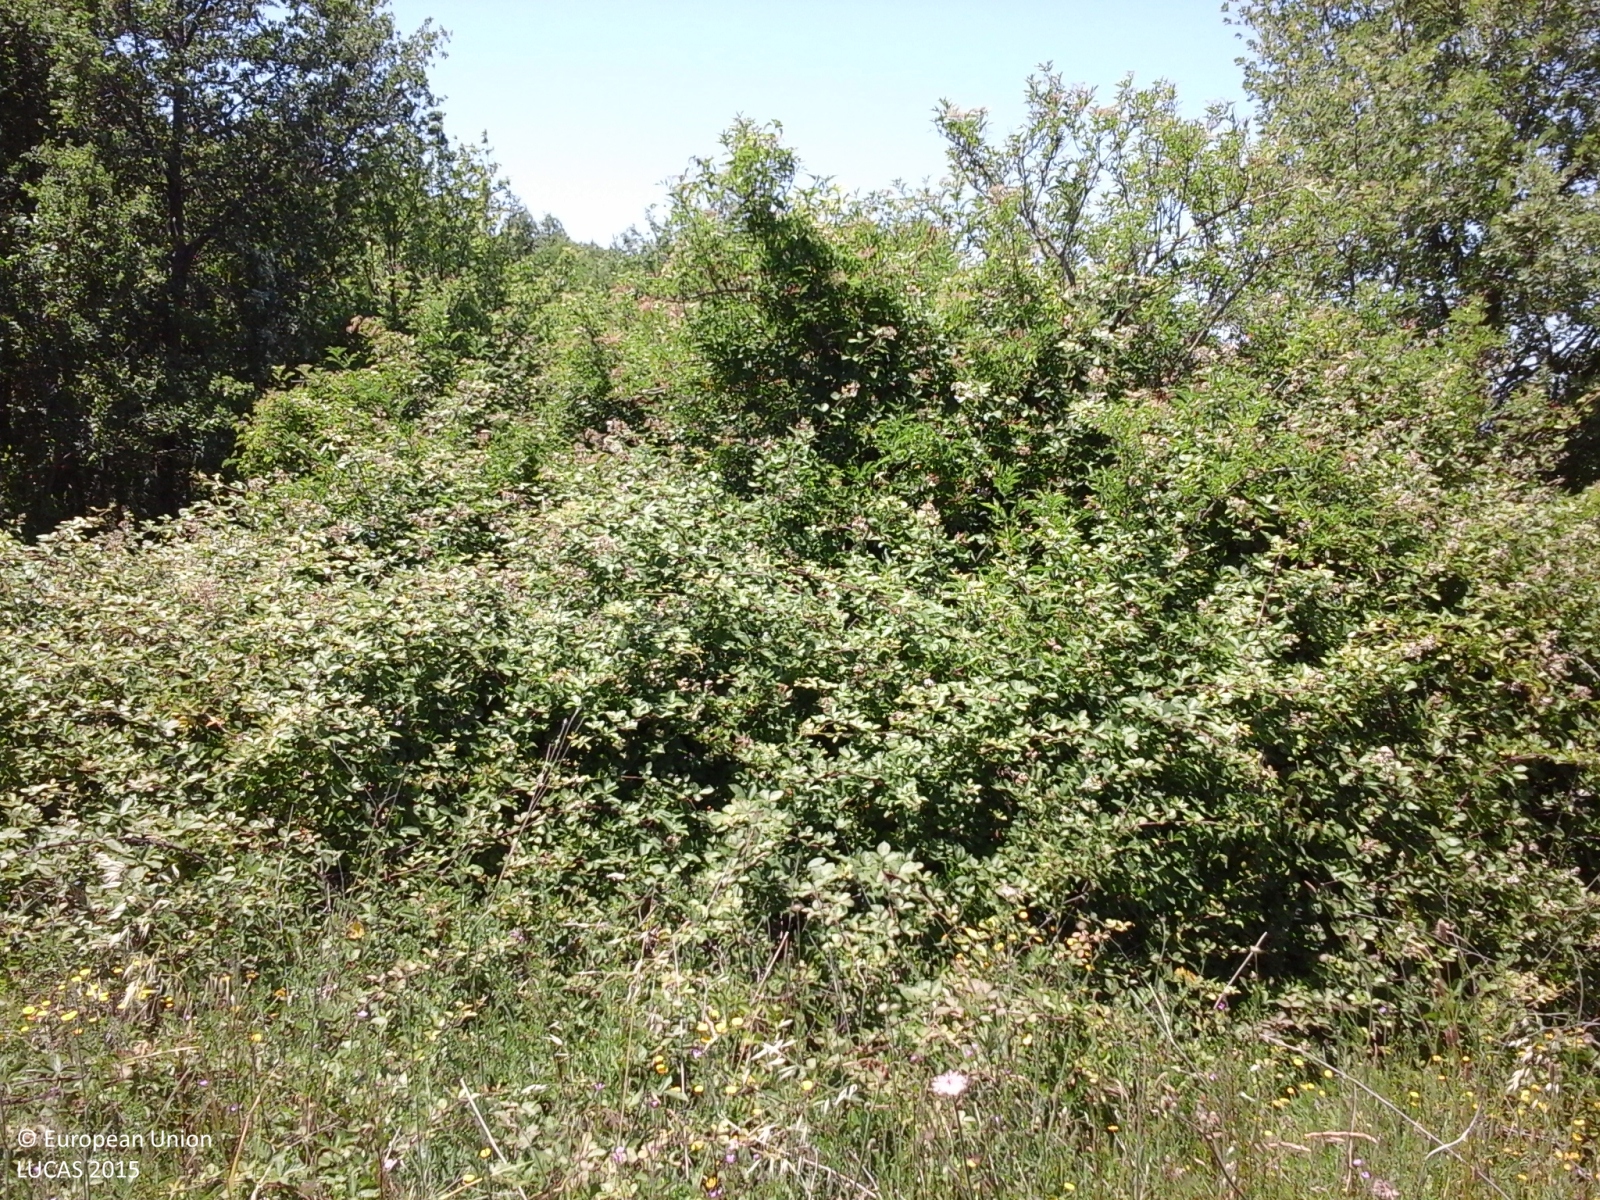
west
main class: Woodland
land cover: Broadleaved woodland
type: thermophilous deciduous forest
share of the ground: > 75 %
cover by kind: broadleaved forest trees 80 %, shrubs 20 %
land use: Semi-natural and natural areas not in use
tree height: < 5 m
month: July
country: IT
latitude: 41.6942
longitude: 14.7062
